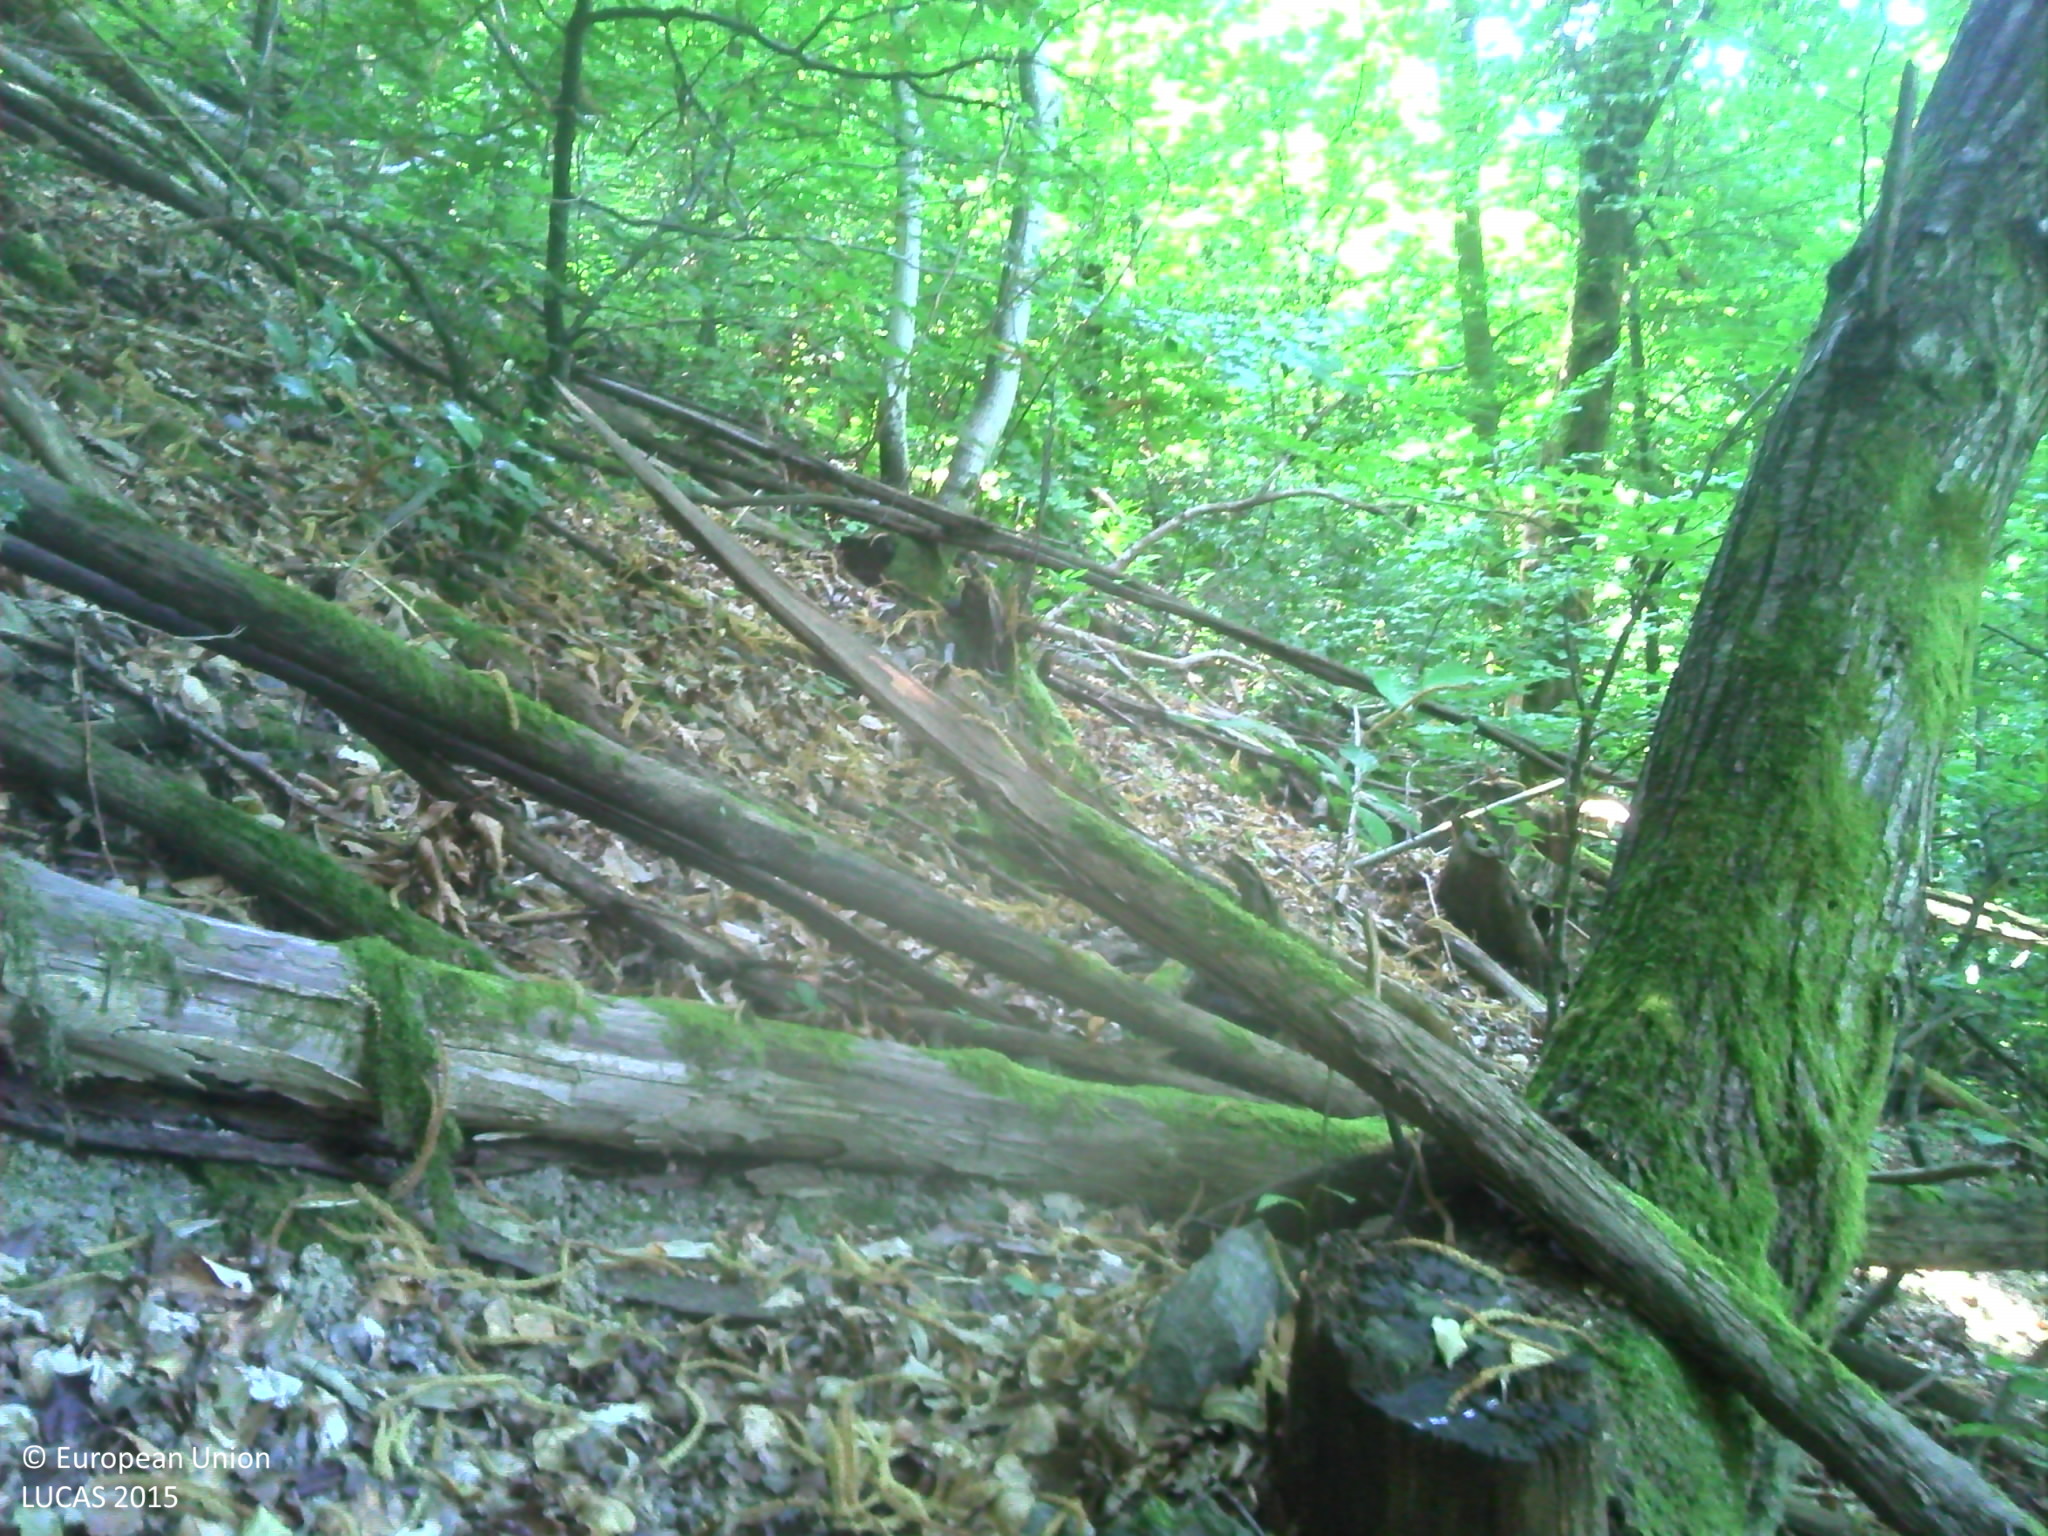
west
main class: Woodland
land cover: Broadleaved woodland
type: mountainous beech forest
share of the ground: > 75 %
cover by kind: broadleaved forest trees 100 %
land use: Forestry
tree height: > 5 m
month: July
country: FR
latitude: 45.6594
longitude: 6.3980
